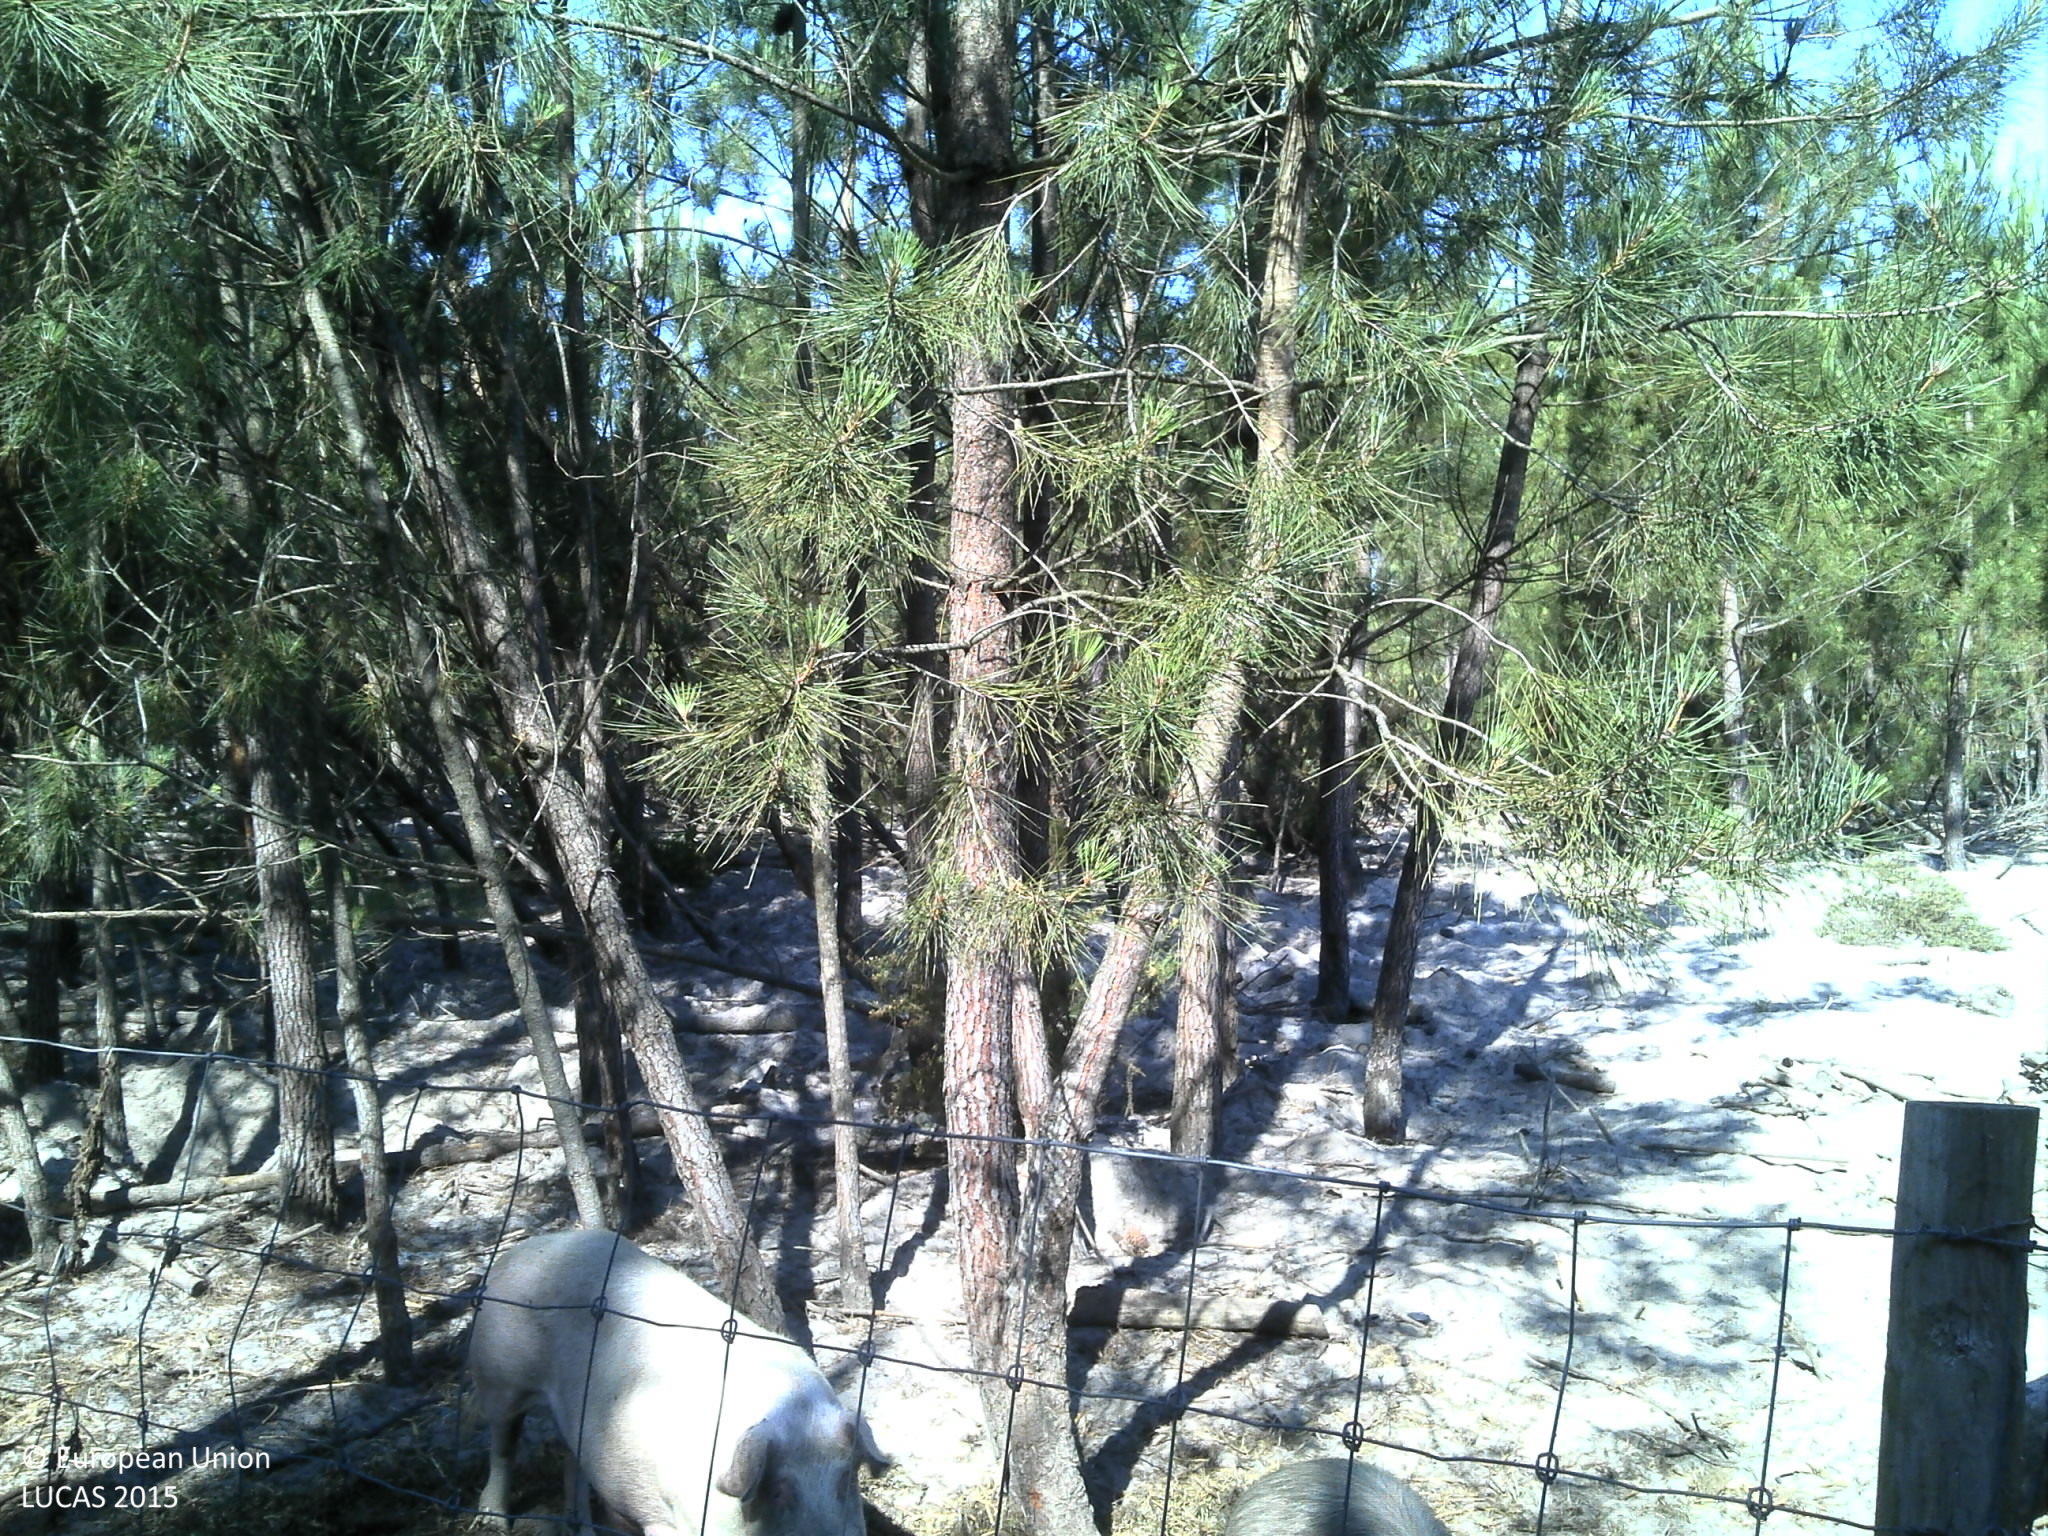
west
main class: Woodland
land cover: Pine dominated coniferous woodland
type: coniferous forest of the mediterranean region
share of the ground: 50 - 75 %
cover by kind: coniferous forest trees 60 %, unconsolidated bare surface 35 %, herbaceous plants 5 %
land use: Forestry
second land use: Agriculture (excluding fallow land and kitchen gardens)
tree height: > 5 m
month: June
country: PT
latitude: 40.3556
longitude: -8.7098
